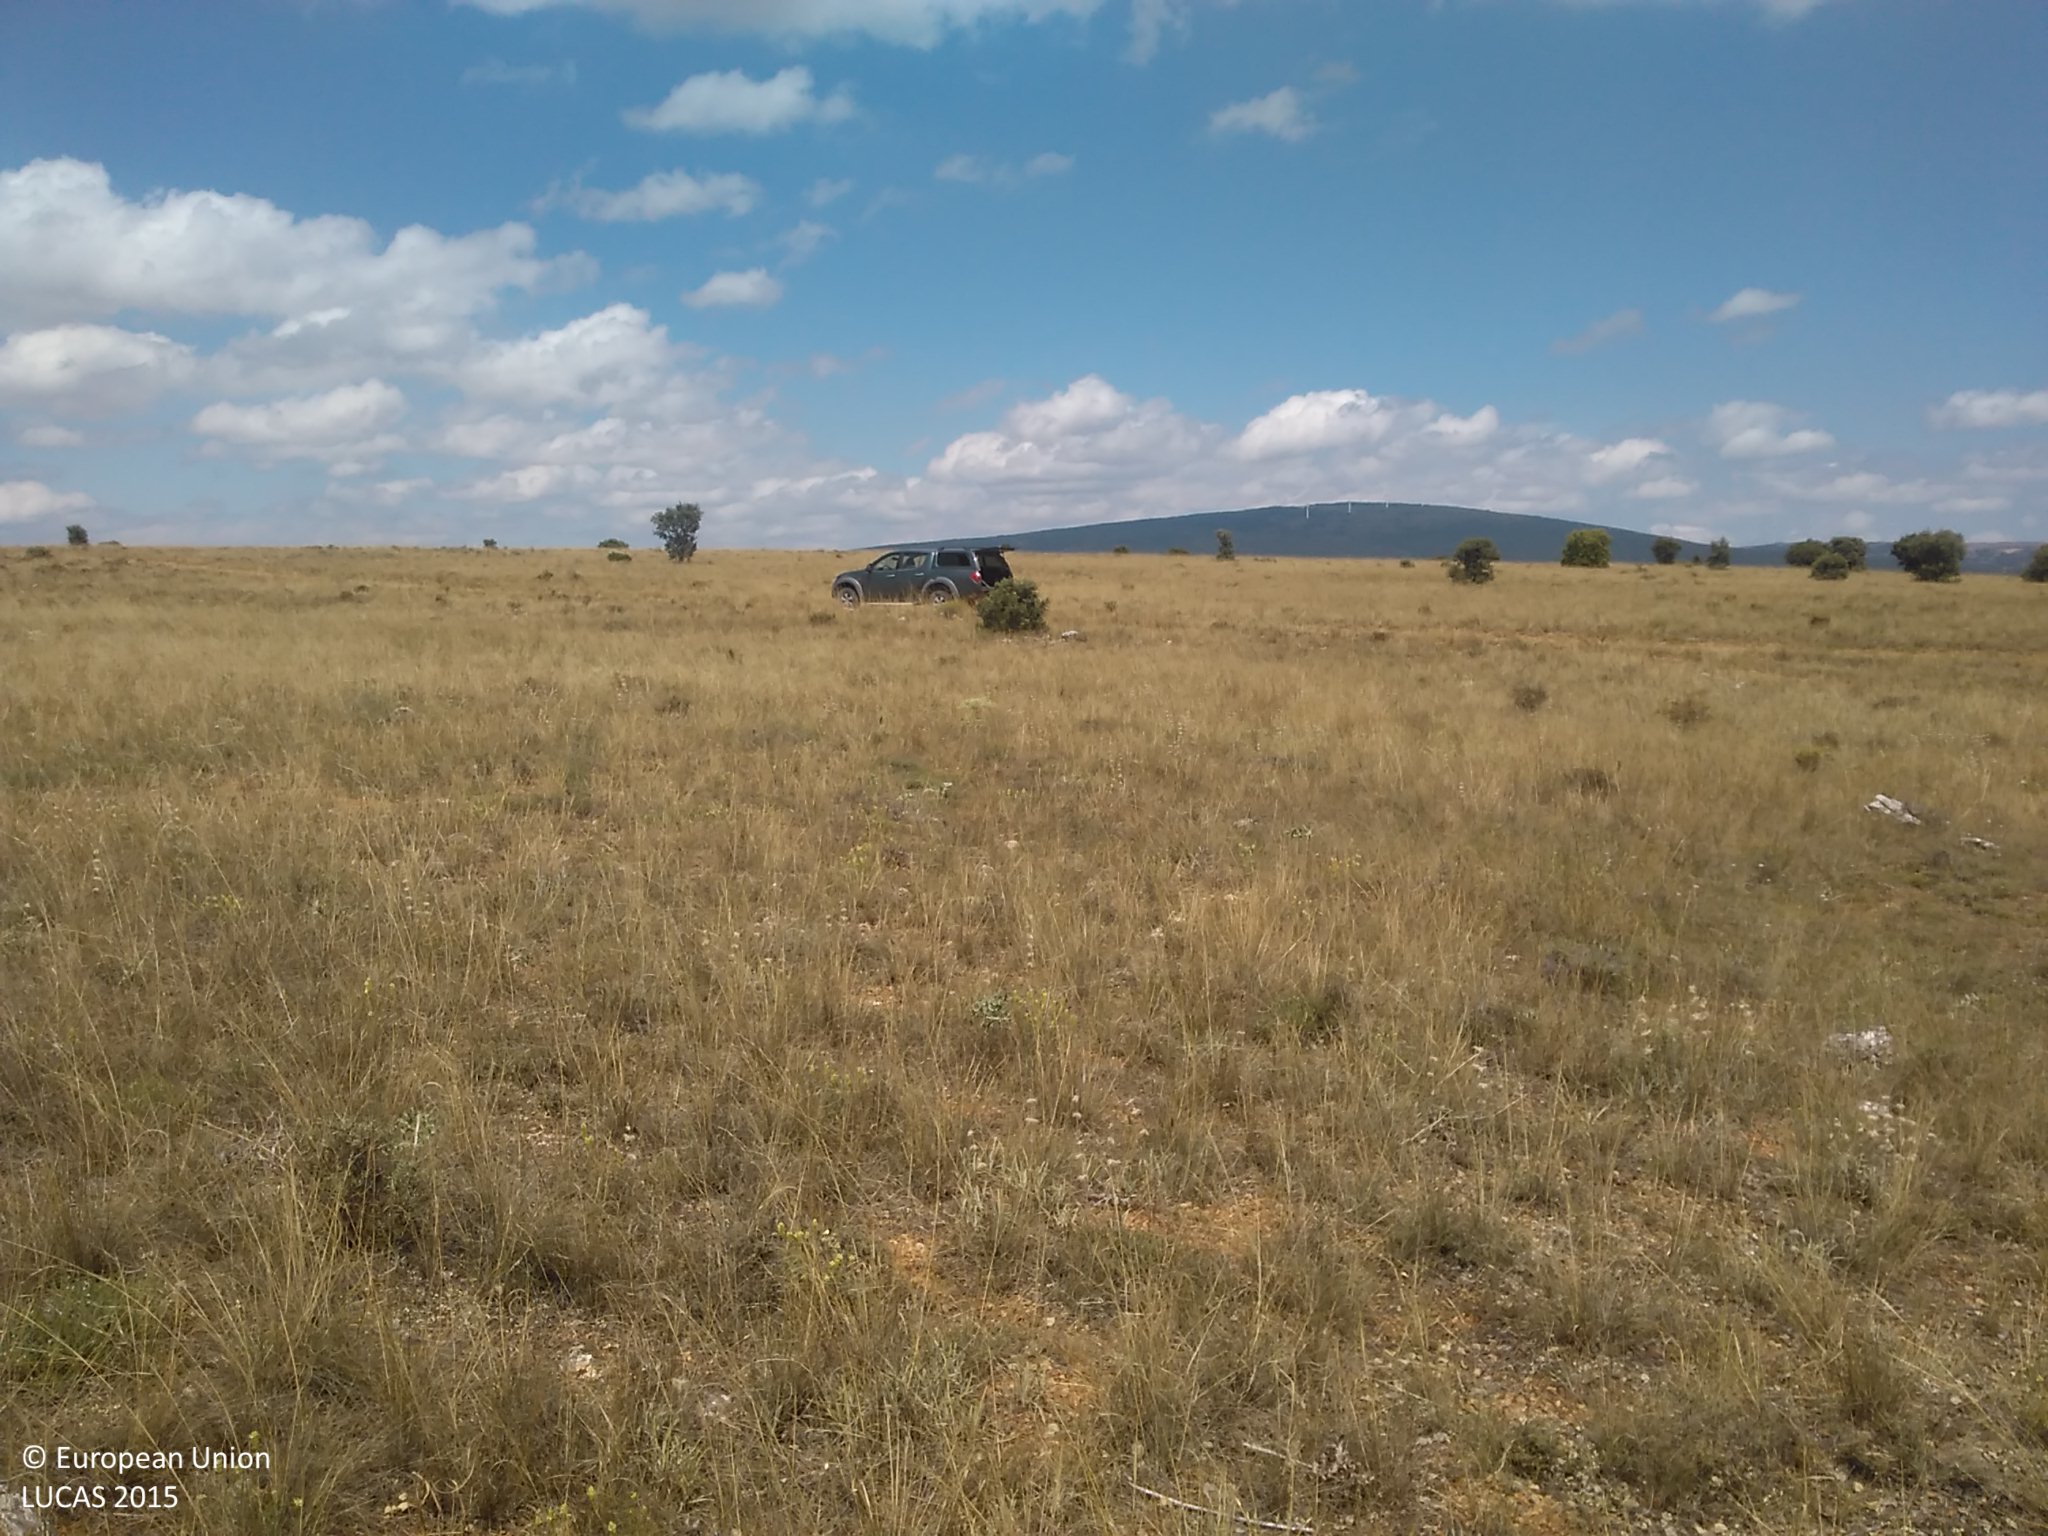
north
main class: Grassland
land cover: Grassland with sparse tree/shrub cover
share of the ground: 10 - 25 %
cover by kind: herbaceous plants 70 %, unconsolidated bare surface 20 %, broadleaved forest trees 5 %, shrubs 5 %
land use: Semi-natural and natural areas not in use
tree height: < 5 m
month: July
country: ES
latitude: 41.7741
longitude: -2.2950
